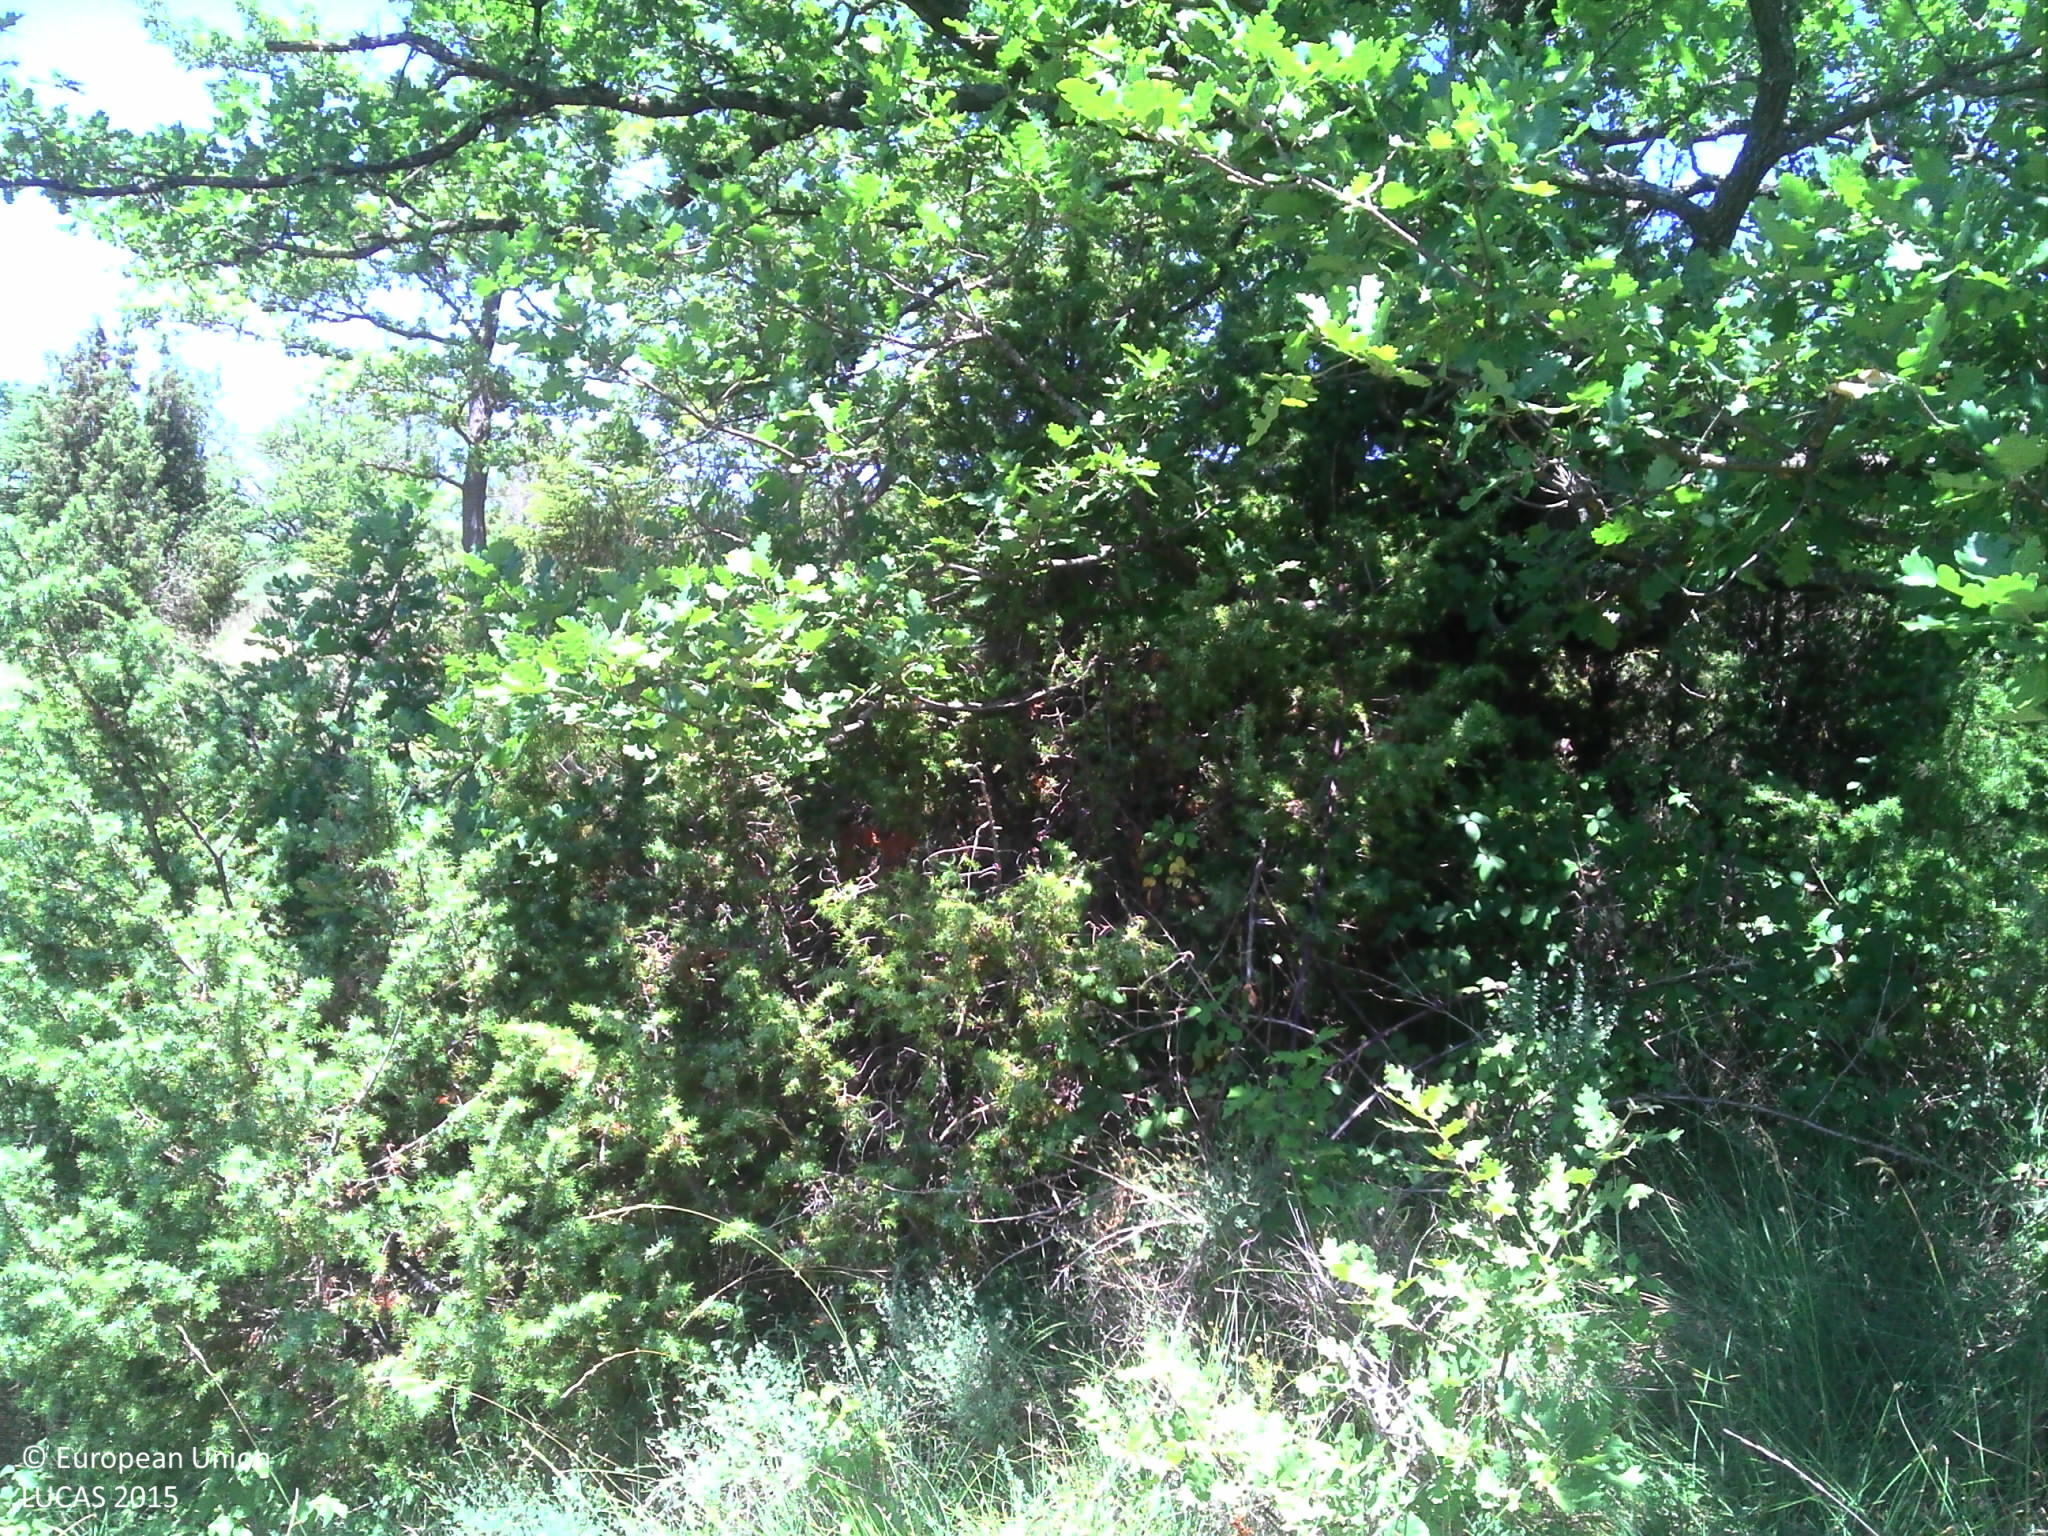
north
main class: Woodland
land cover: Other mixed woodland
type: thermophilous deciduous forest
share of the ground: 50 - 75 %
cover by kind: coniferous forest trees 35 %, broadleaved forest trees 35 %, herbaceous plants 30 %
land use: Semi-natural and natural areas not in use
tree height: < 5 m
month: July
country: FR
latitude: 42.9835
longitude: 2.1478
